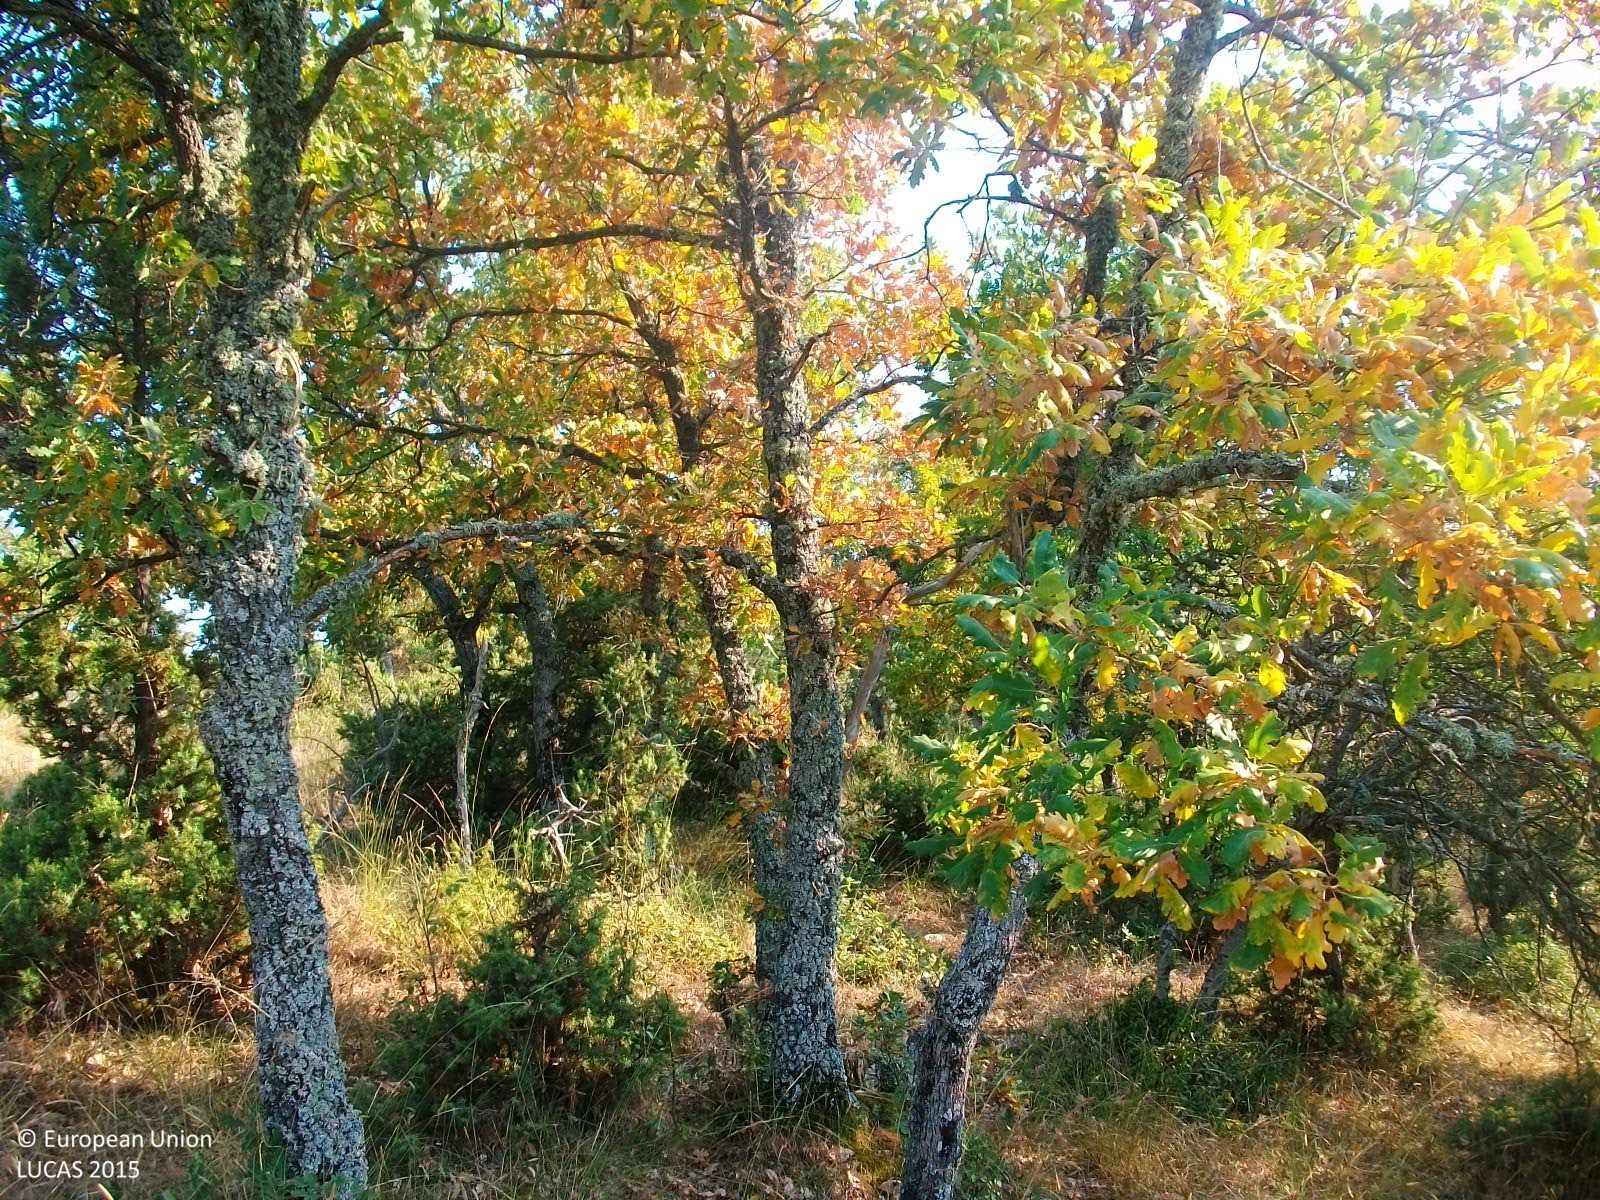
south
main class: Woodland
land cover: Broadleaved woodland
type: thermophilous deciduous forest
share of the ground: > 75 %
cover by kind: broadleaved forest trees 100 %
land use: Forestry
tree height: > 5 m
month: July
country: GR
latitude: 41.3291
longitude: 26.0409
